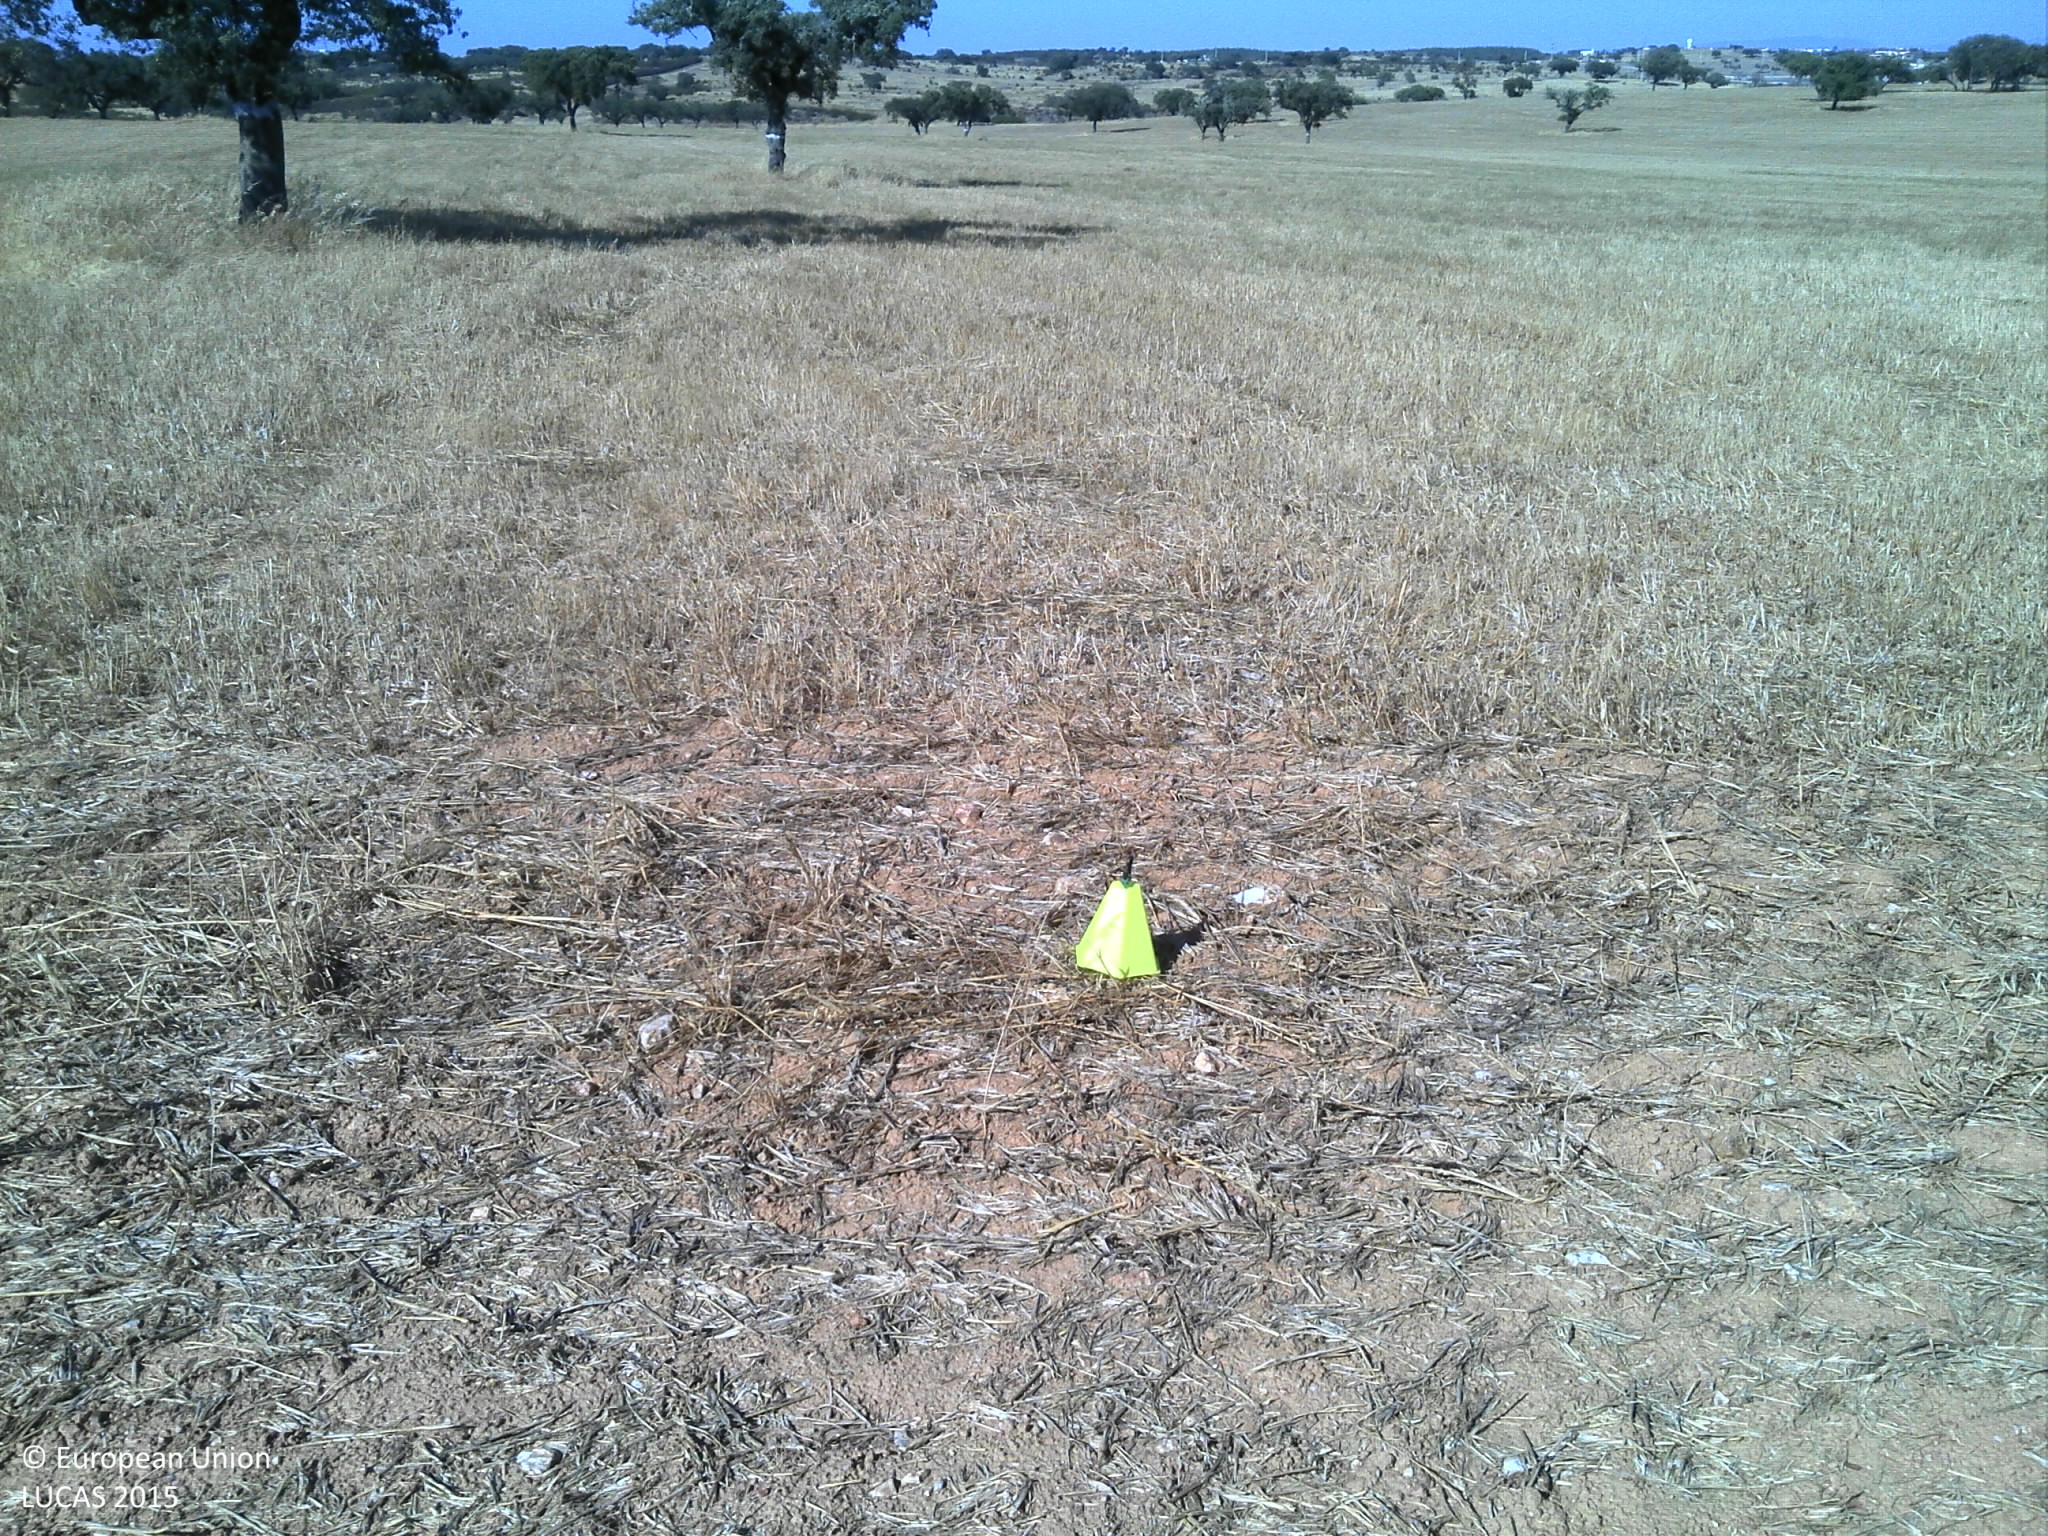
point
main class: Woodland
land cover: Broadleaved woodland
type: broadleaved evergreen forest
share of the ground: 10 - 25 %
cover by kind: unconsolidated bare surface 65 %, herbaceous plants 25 %, broadleaved forest trees 10 %
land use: Forestry
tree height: > 5 m
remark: Harvested field
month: July
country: PT
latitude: 38.5275
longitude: -7.4286
